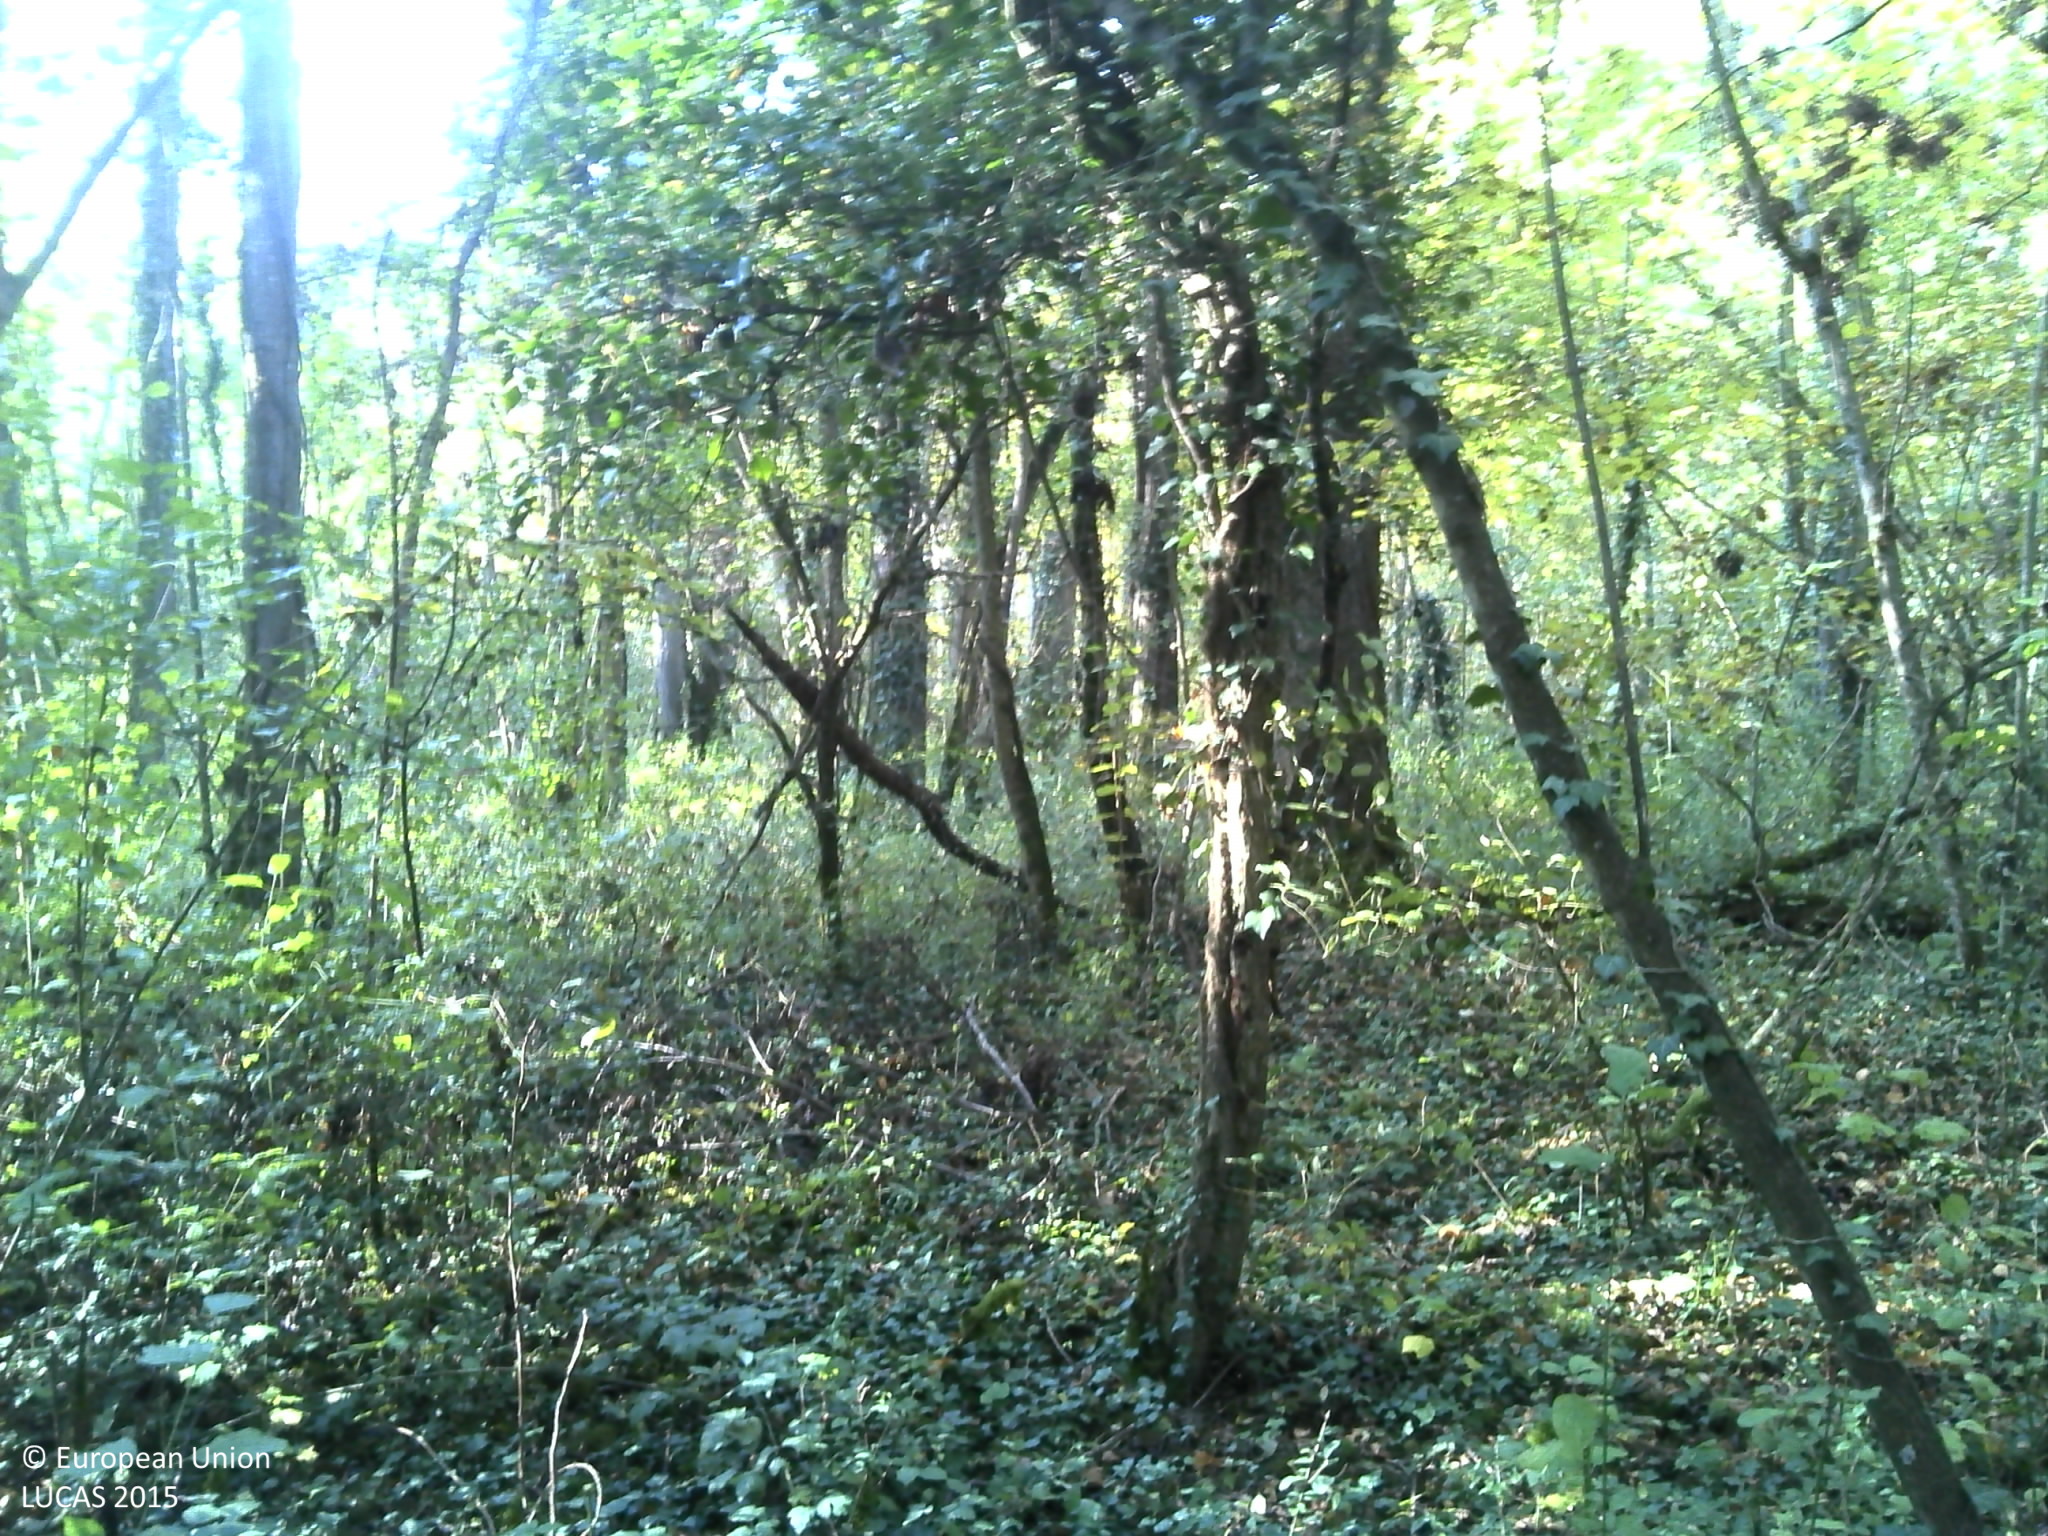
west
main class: Woodland
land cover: Broadleaved woodland
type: mesophytic deciduous forest
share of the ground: > 75 %
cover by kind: broadleaved forest trees 100 %
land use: Forestry
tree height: > 5 m
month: October
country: FR
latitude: 47.1854
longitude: 5.2899
